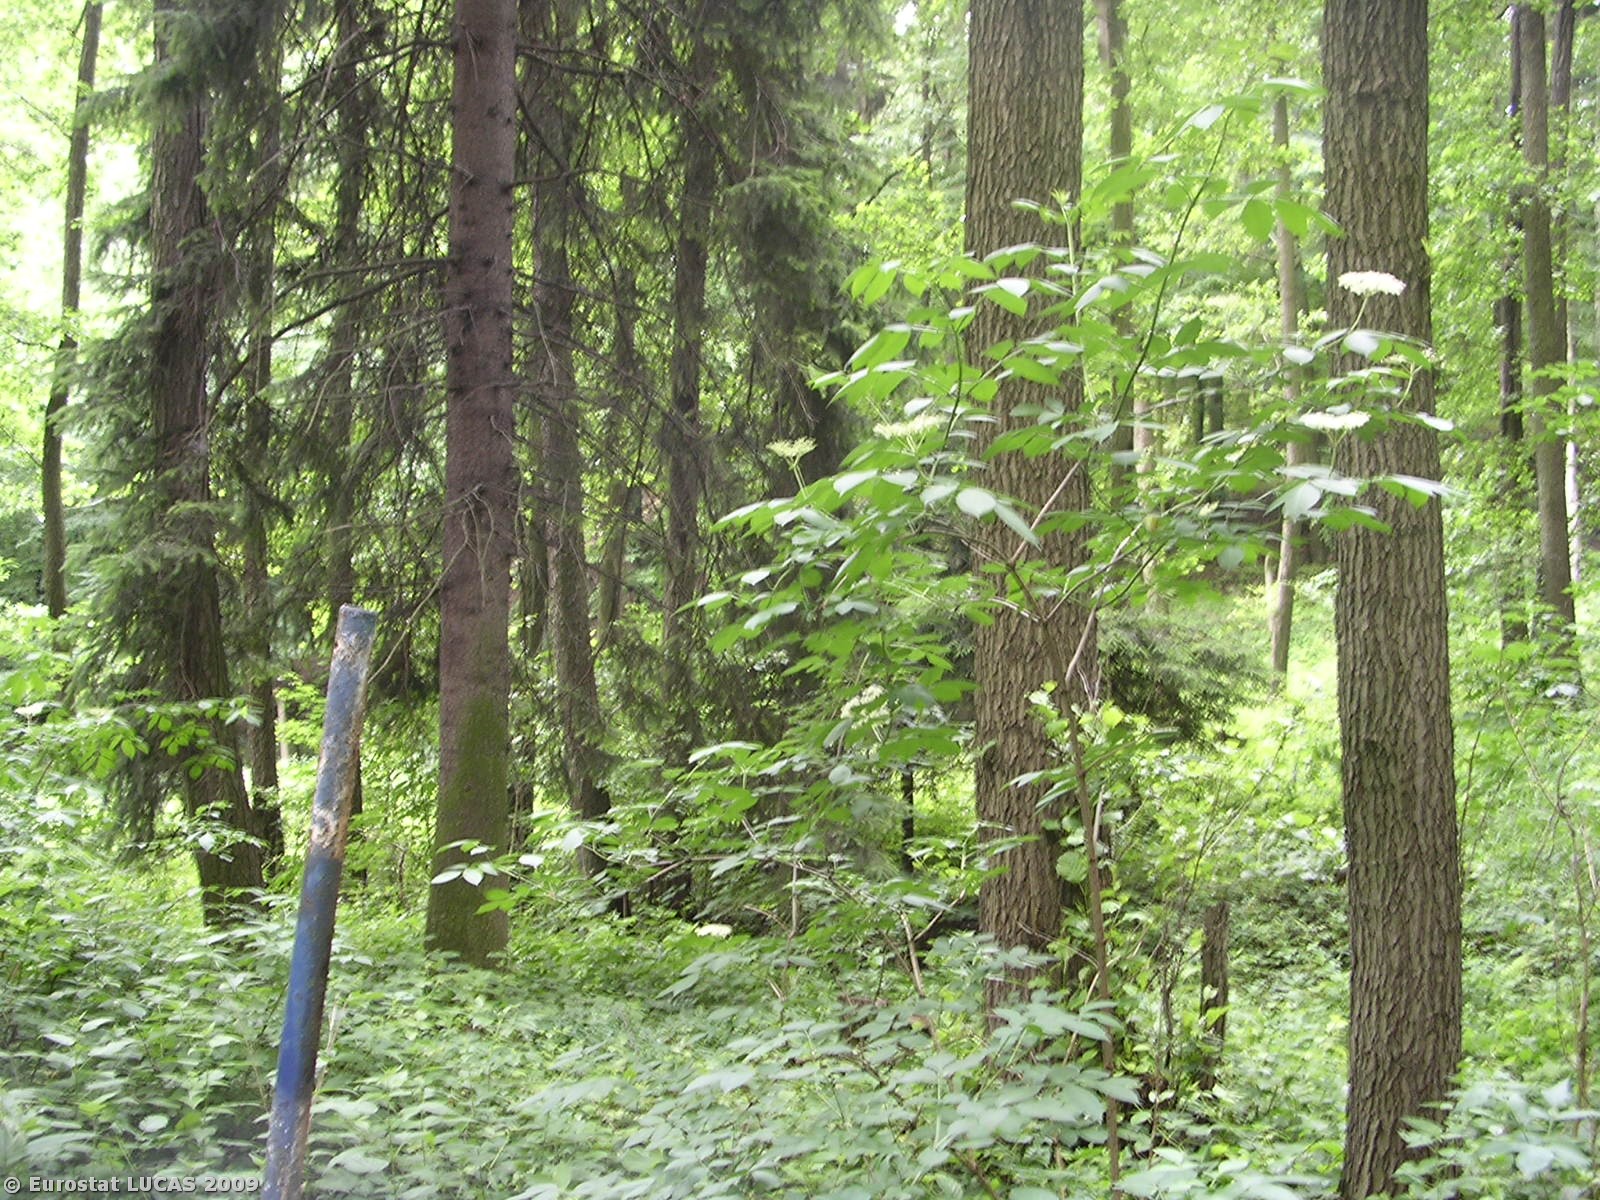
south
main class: Woodland
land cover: Mixed woodland
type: hemiboreal forest and nemoral coniferous forest and mixed broadleaved-coniferous forest
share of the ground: > 75 %
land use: Water supply and treatment
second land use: Forestry
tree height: > 5 m
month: June
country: CZ
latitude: 50.6069
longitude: 14.3112
